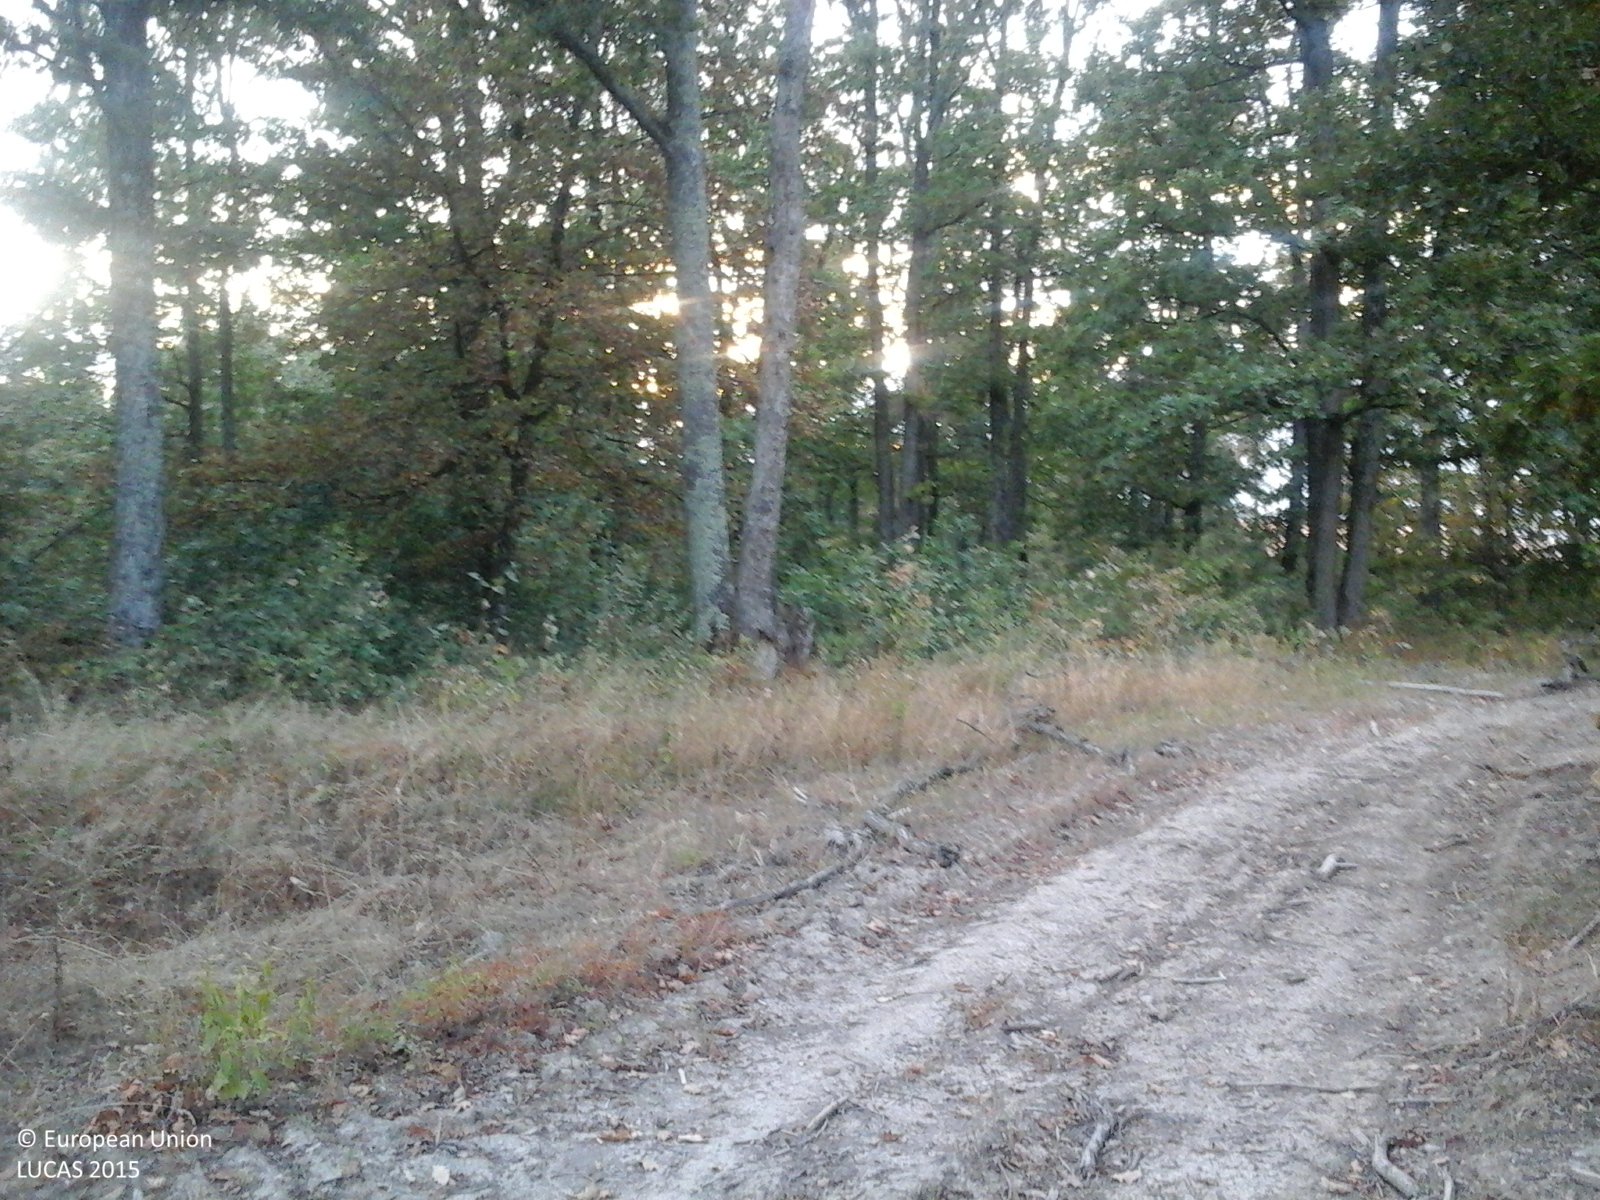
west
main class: Woodland
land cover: Broadleaved woodland
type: acidophilous oak and oak-birch forest
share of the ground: > 75 %
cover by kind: broadleaved forest trees 100 %
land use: Forestry
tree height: > 5 m
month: September
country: RO
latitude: 47.6529
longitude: 23.1289
